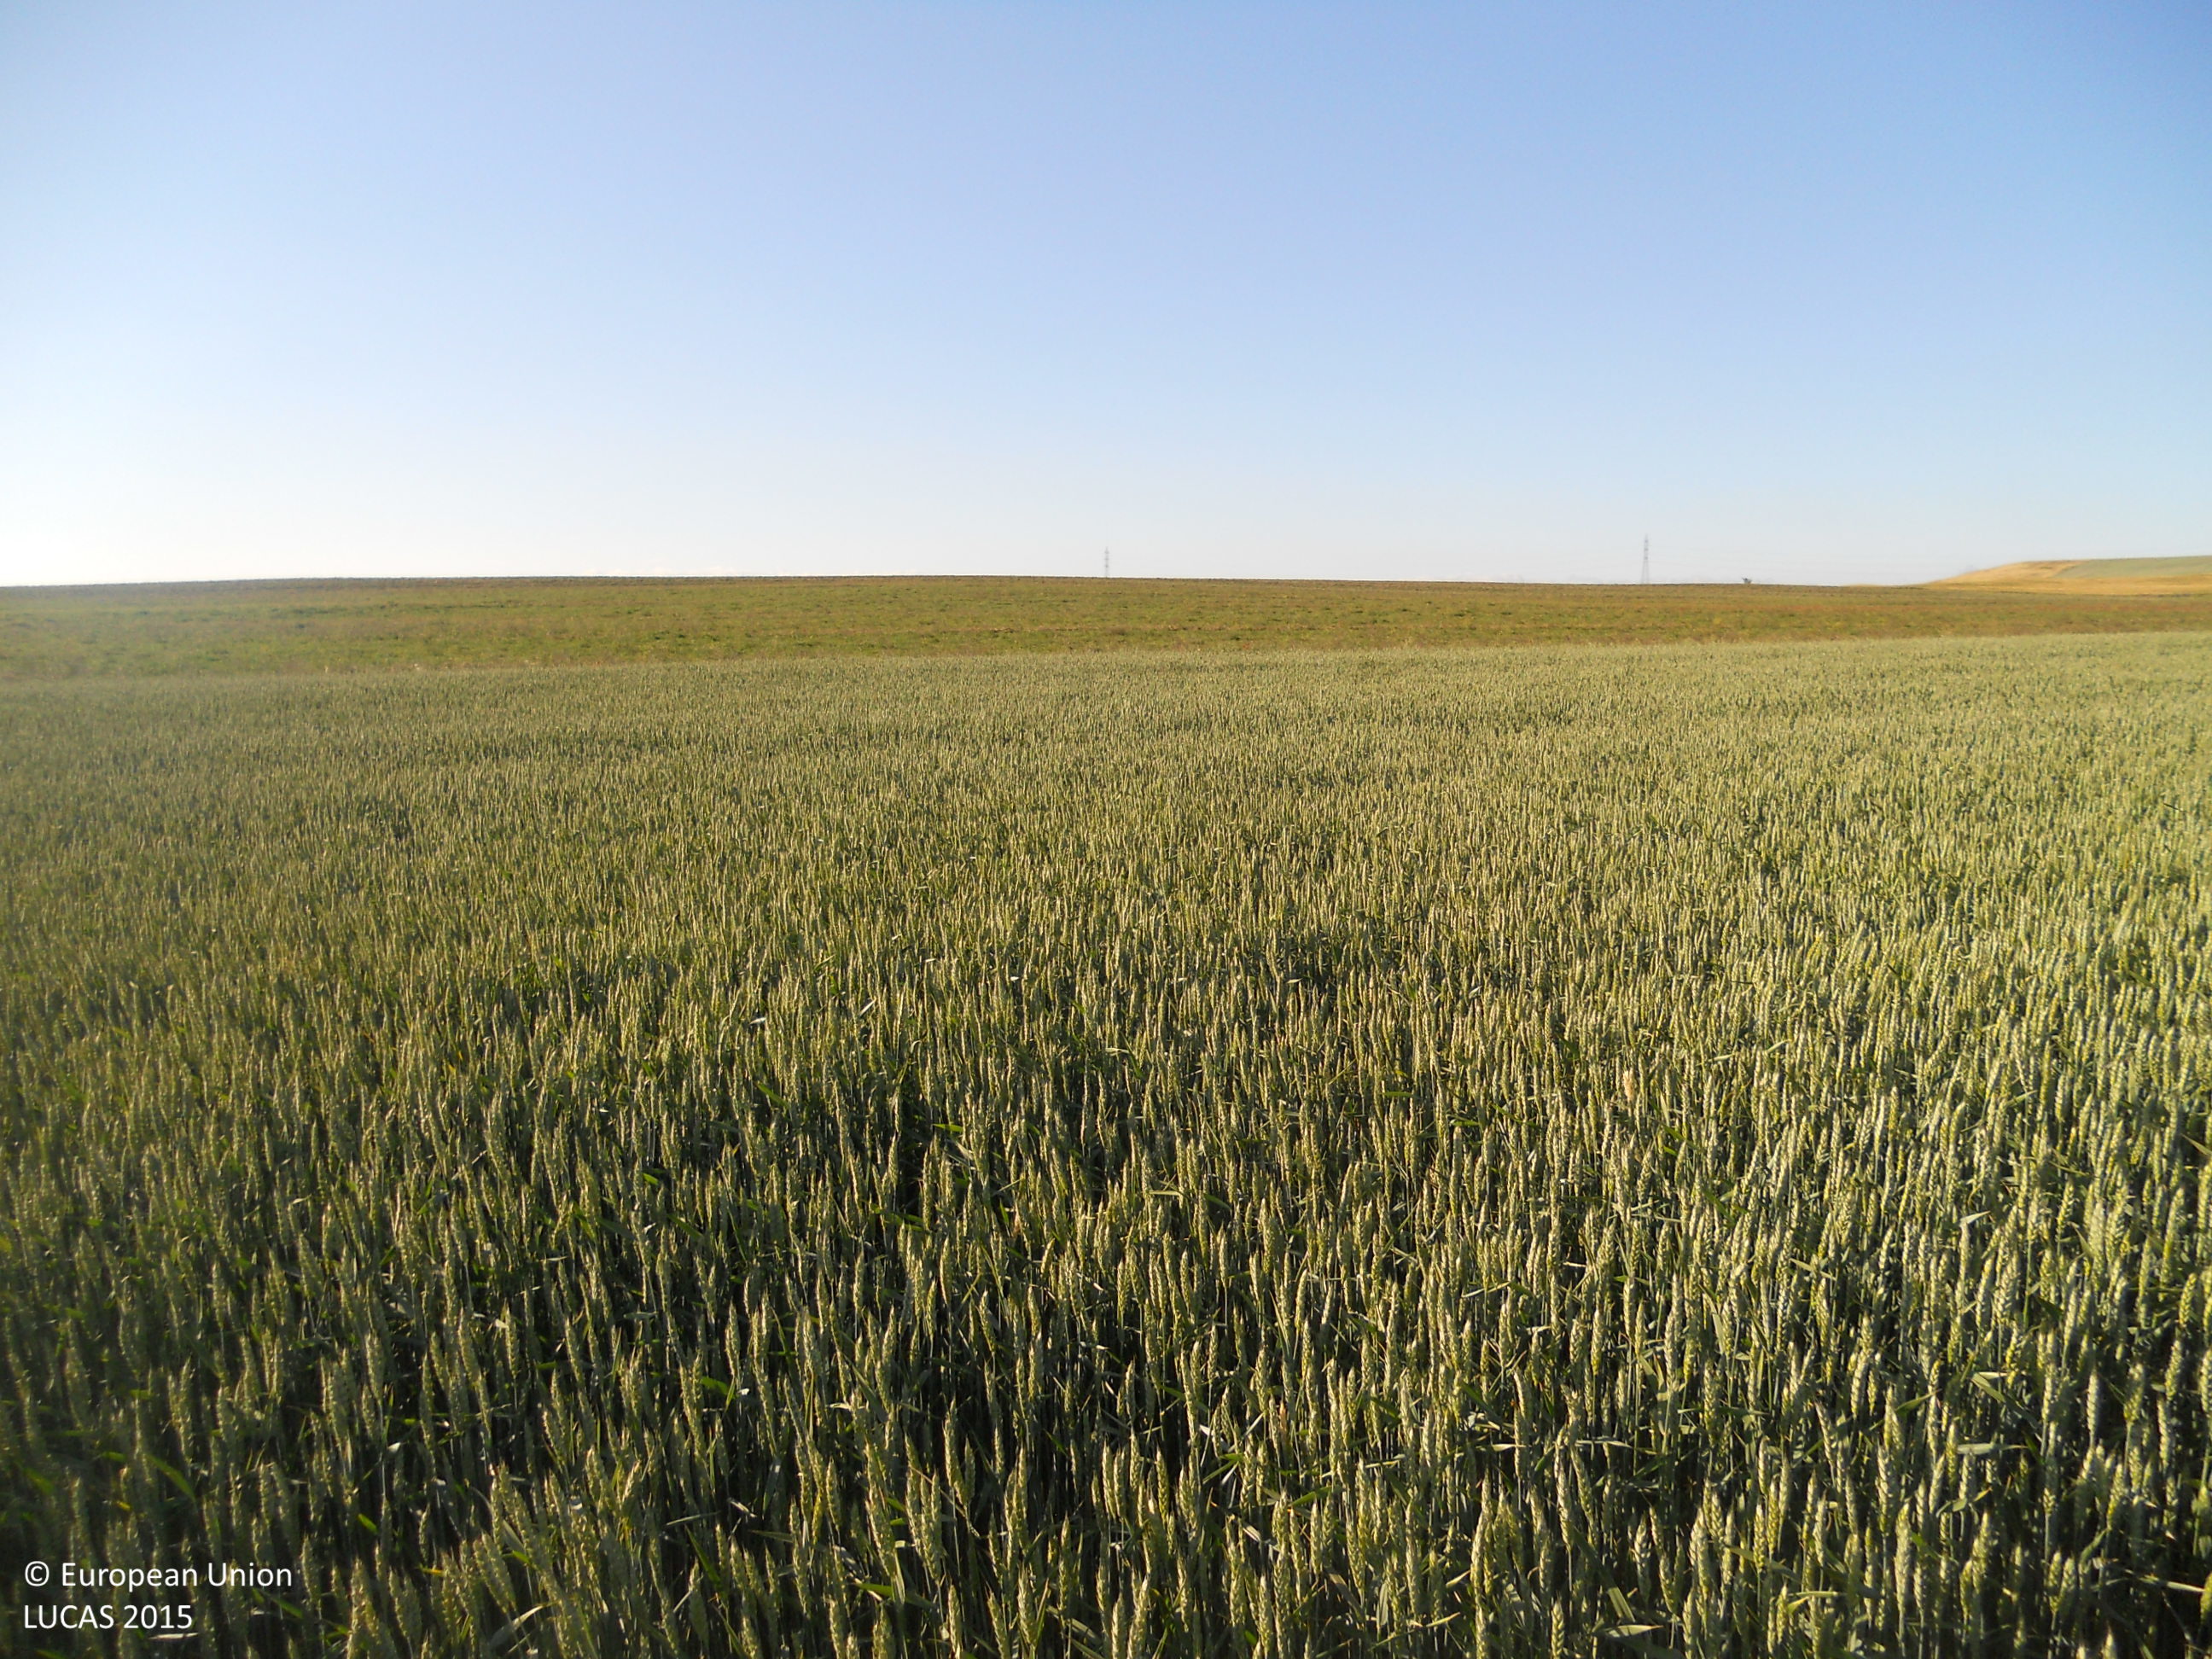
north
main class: Cropland
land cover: Common wheat
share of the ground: > 75 %
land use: Agriculture (excluding fallow land and kitchen gardens)
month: May
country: ES
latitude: 42.3782
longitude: -4.3416
